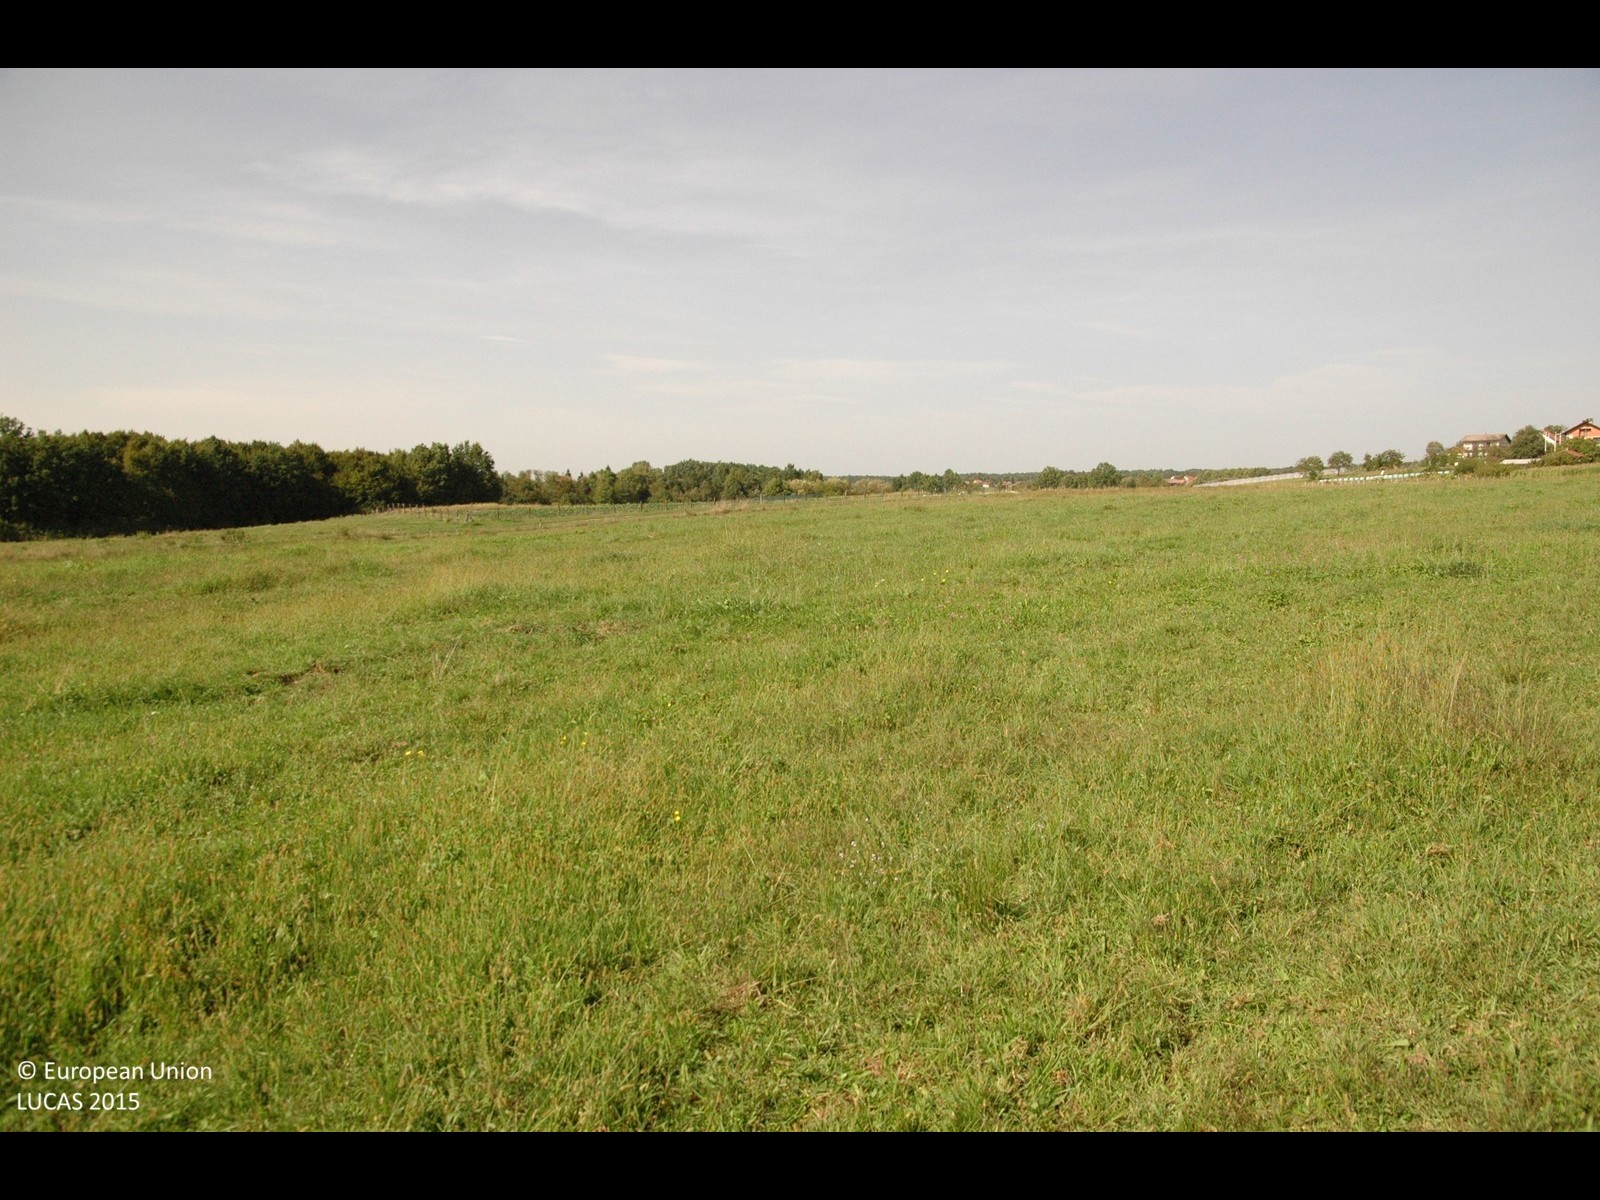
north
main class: Grassland
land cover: Grassland without tree/shrub cover
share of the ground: > 75 %
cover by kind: herbaceous plants 100 %
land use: Agriculture (excluding fallow land and kitchen gardens)
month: September
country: HR
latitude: 45.6142
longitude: 15.8318
